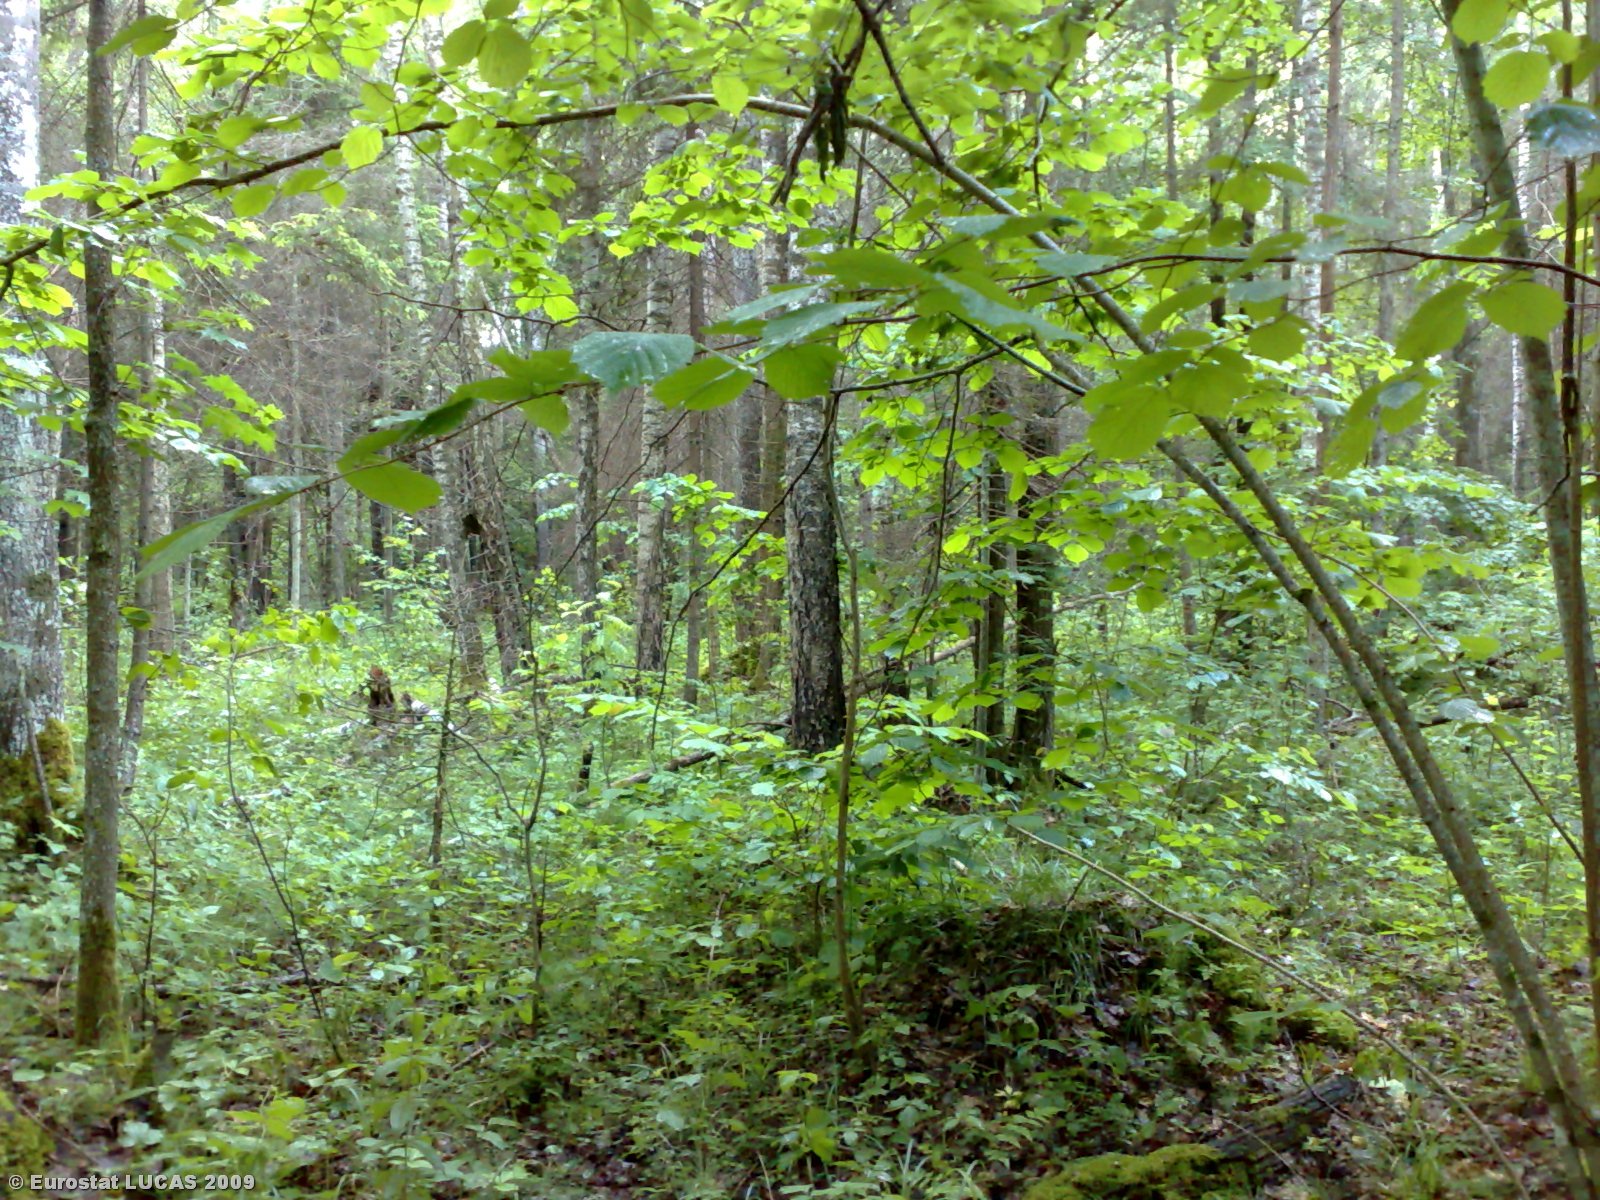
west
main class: Woodland
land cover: Mixed woodland
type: hemiboreal forest and nemoral coniferous forest and mixed broadleaved-coniferous forest
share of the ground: > 75 %
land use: Forestry
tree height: > 5 m
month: June
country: LT
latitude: 55.9412
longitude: 23.8698
